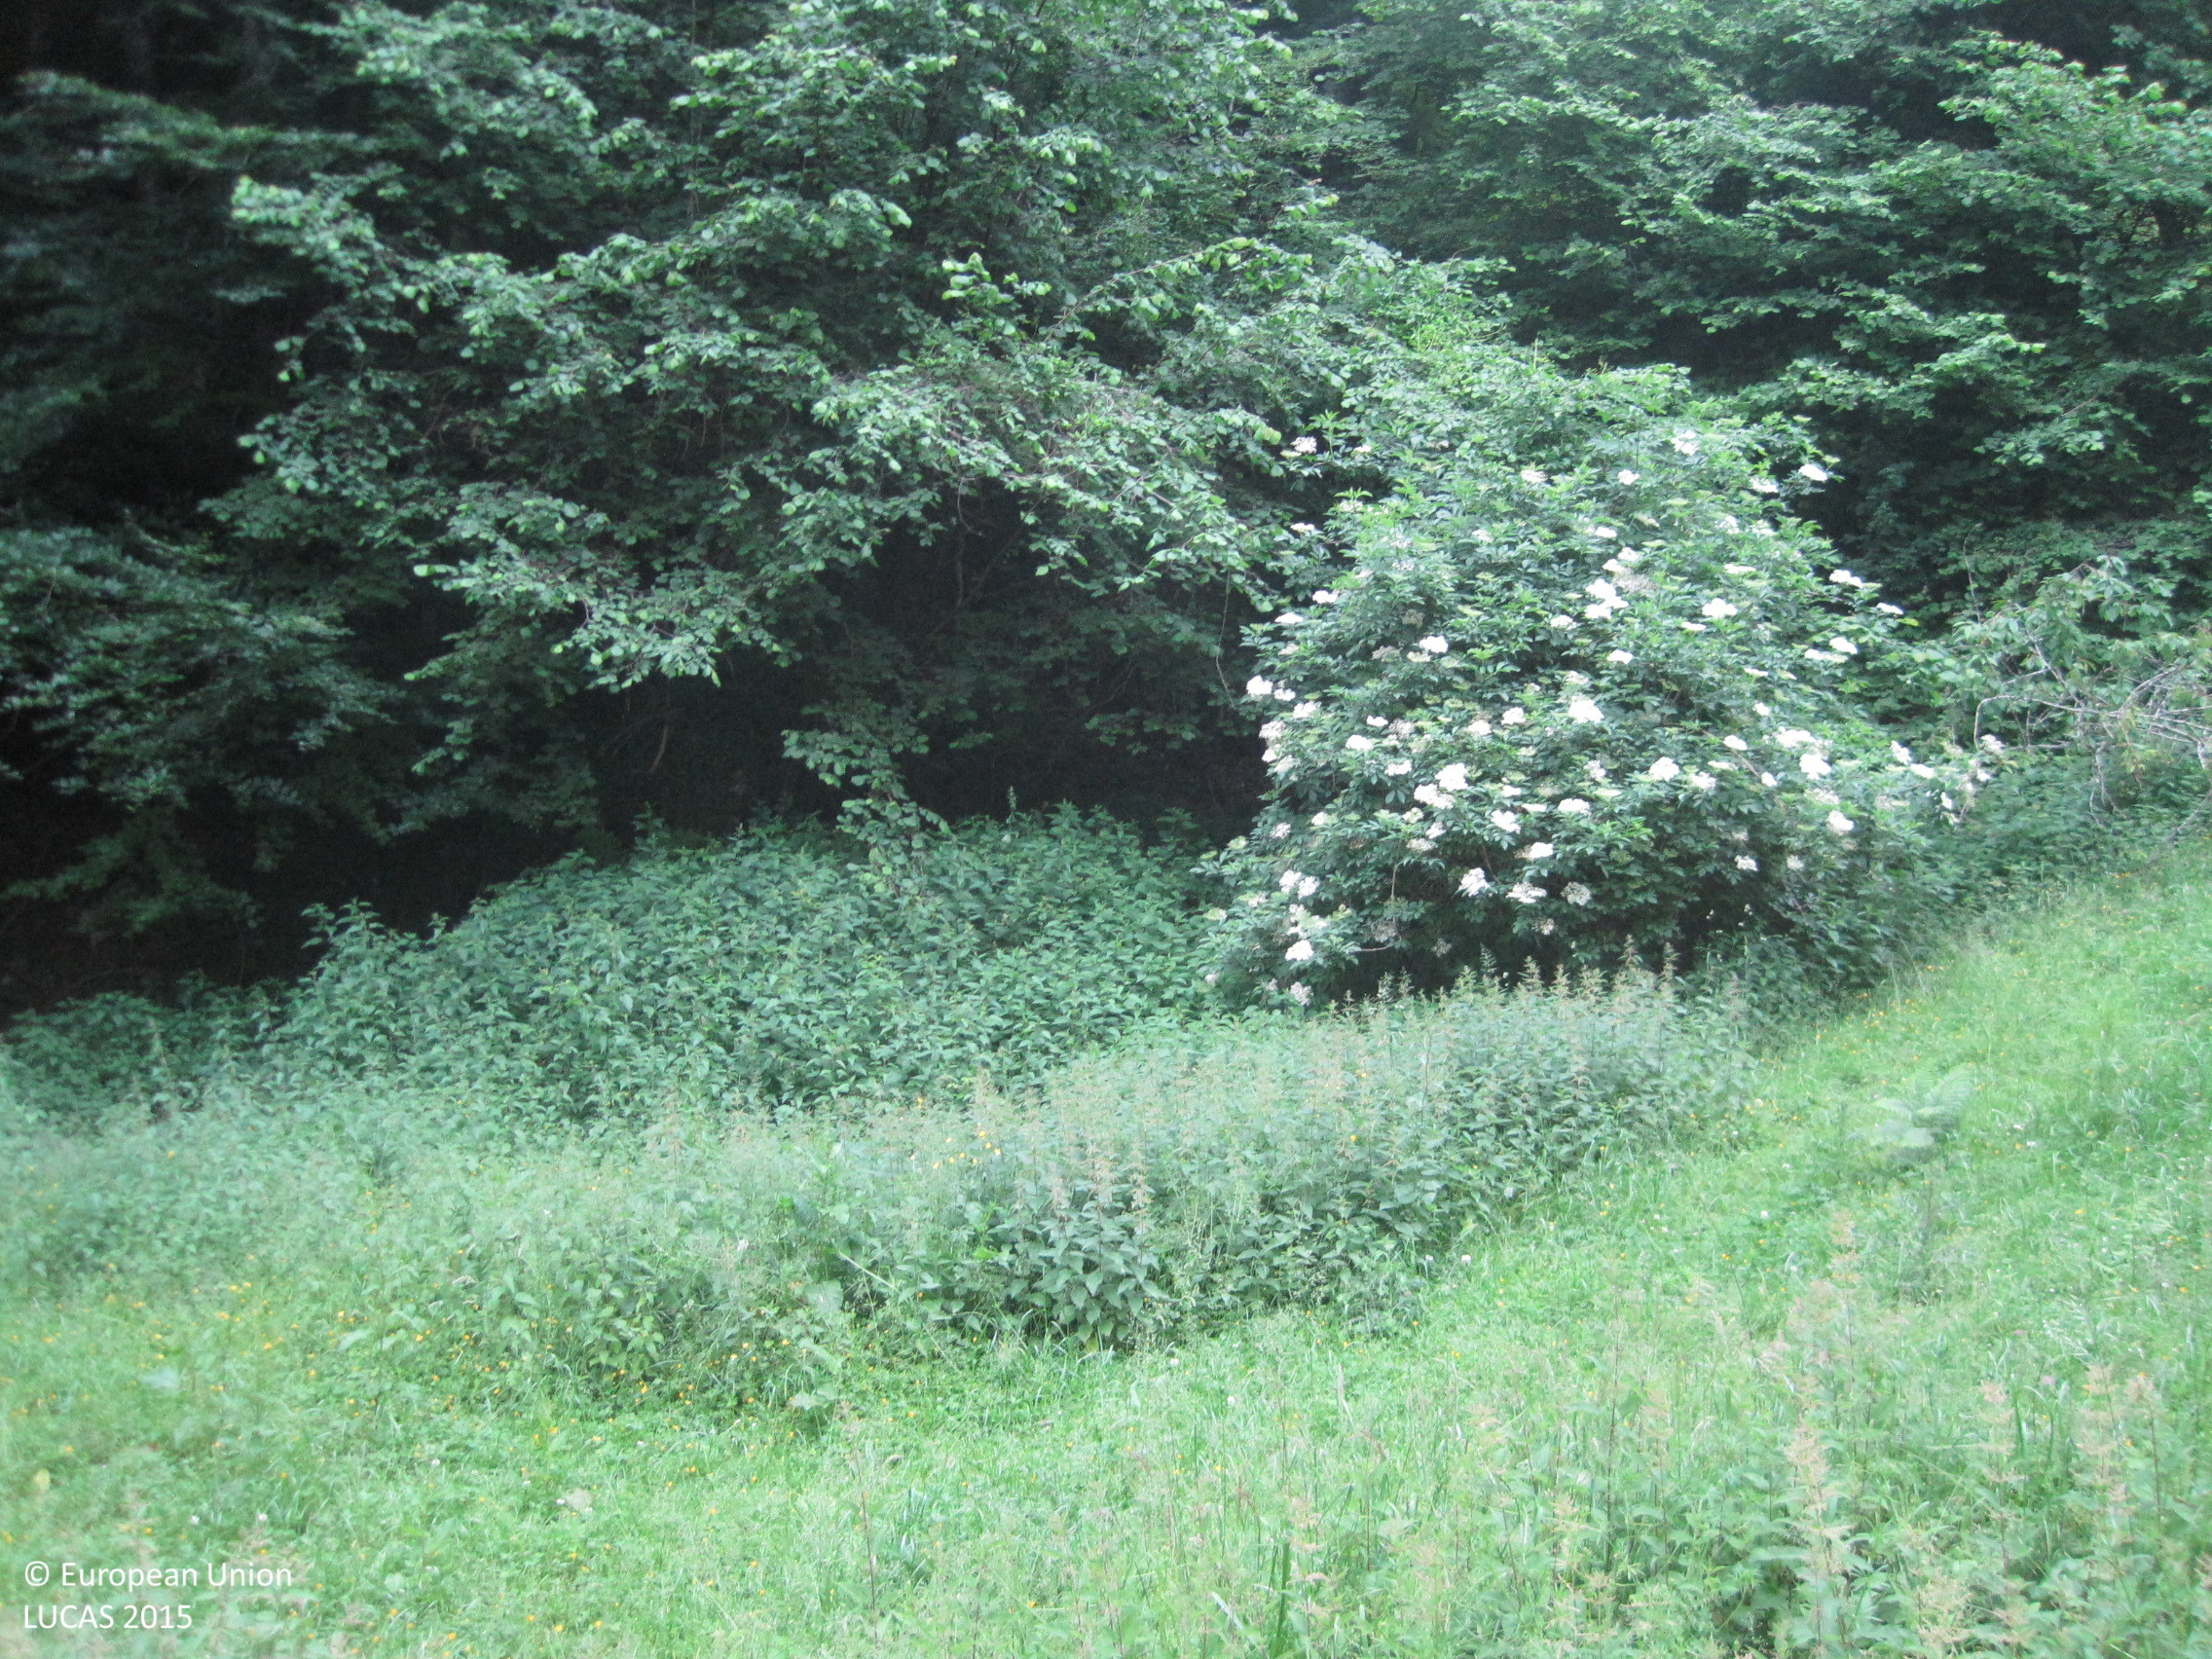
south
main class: Woodland
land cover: Broadleaved woodland
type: beech forest
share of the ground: 50 - 75 %
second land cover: Grassland without tree/shrub cover
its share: > 75 %
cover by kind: herbaceous plants 60 %, broadleaved forest trees 40 %
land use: Forestry
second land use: Agriculture (excluding fallow land and kitchen gardens)
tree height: > 5 m
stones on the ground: < 10 %
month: June
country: ES
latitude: 43.0356
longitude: -1.8134
